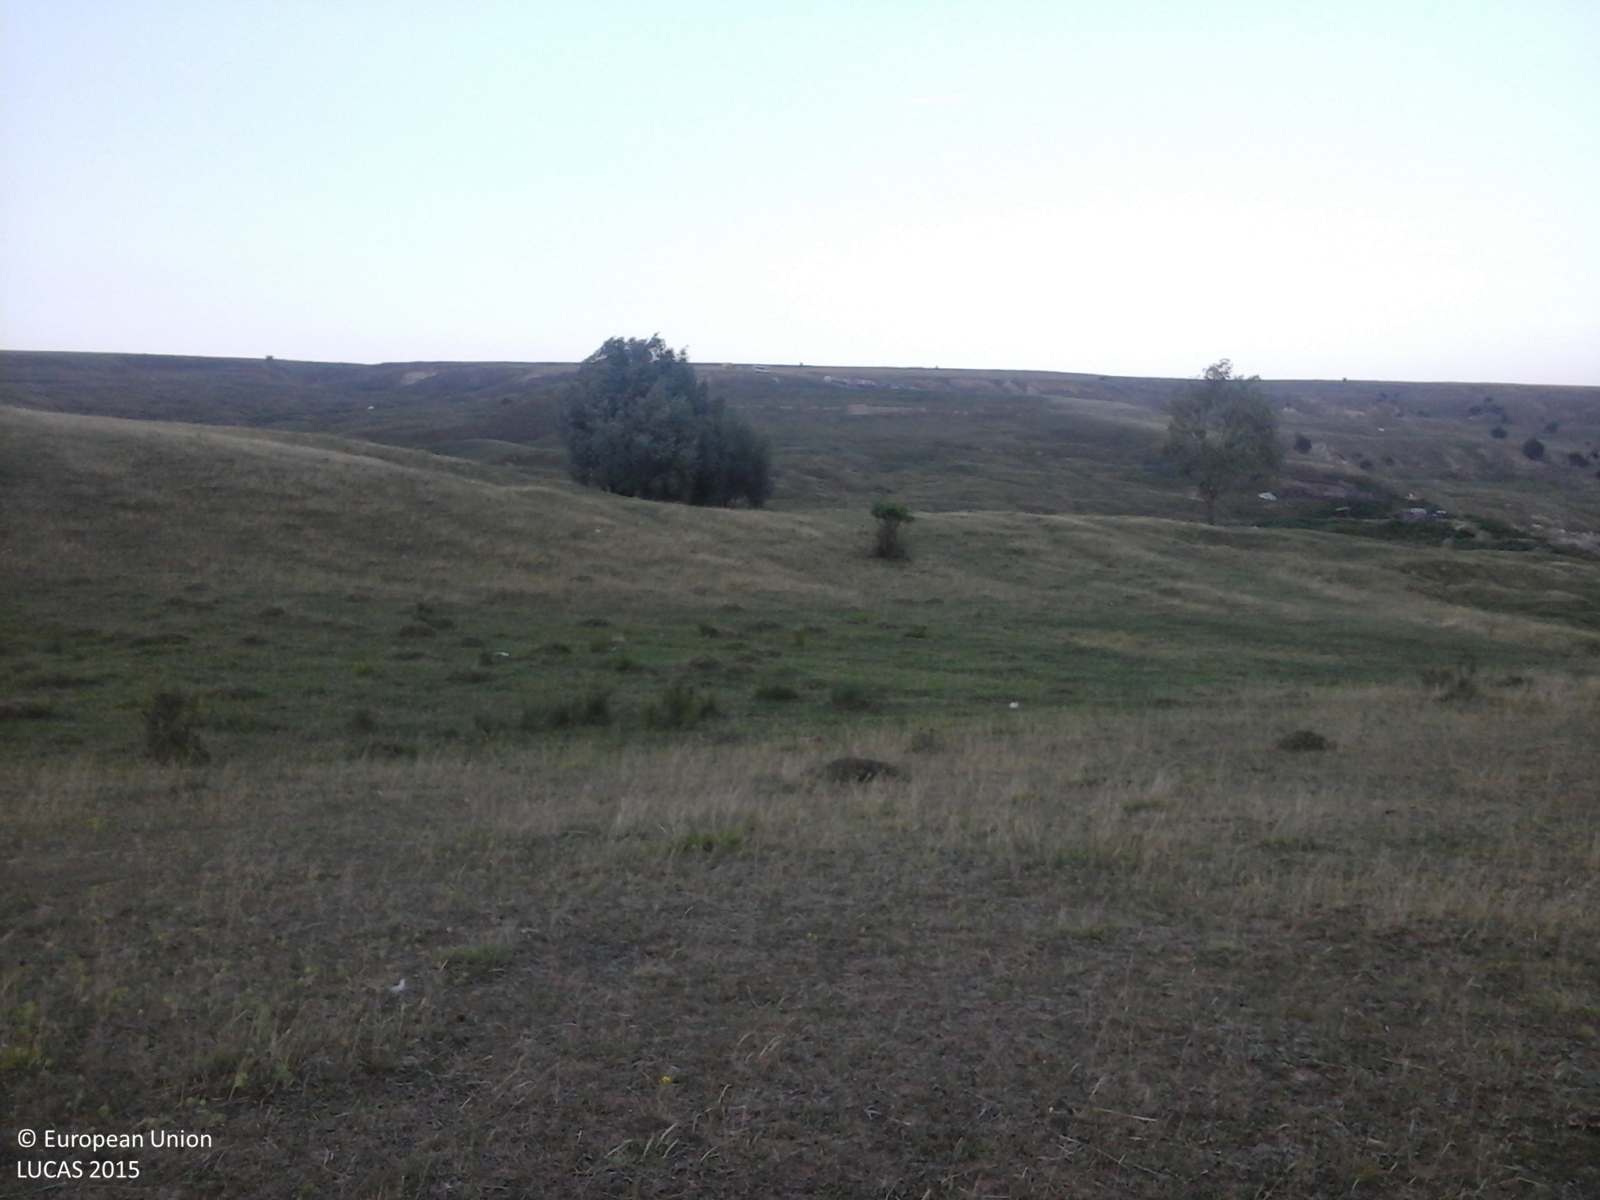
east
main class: Grassland
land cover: Grassland without tree/shrub cover
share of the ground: > 75 %
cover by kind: herbaceous plants 100 %
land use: Agriculture (excluding fallow land and kitchen gardens)
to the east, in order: Grassland without tree/shrub cover; Grassland with sparse tree/shrub cover; Grassland without tree/shrub cover; Ditches and canals; Grassland without tree/shrub cover
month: June
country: RO
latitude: 46.8270
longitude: 27.0497
